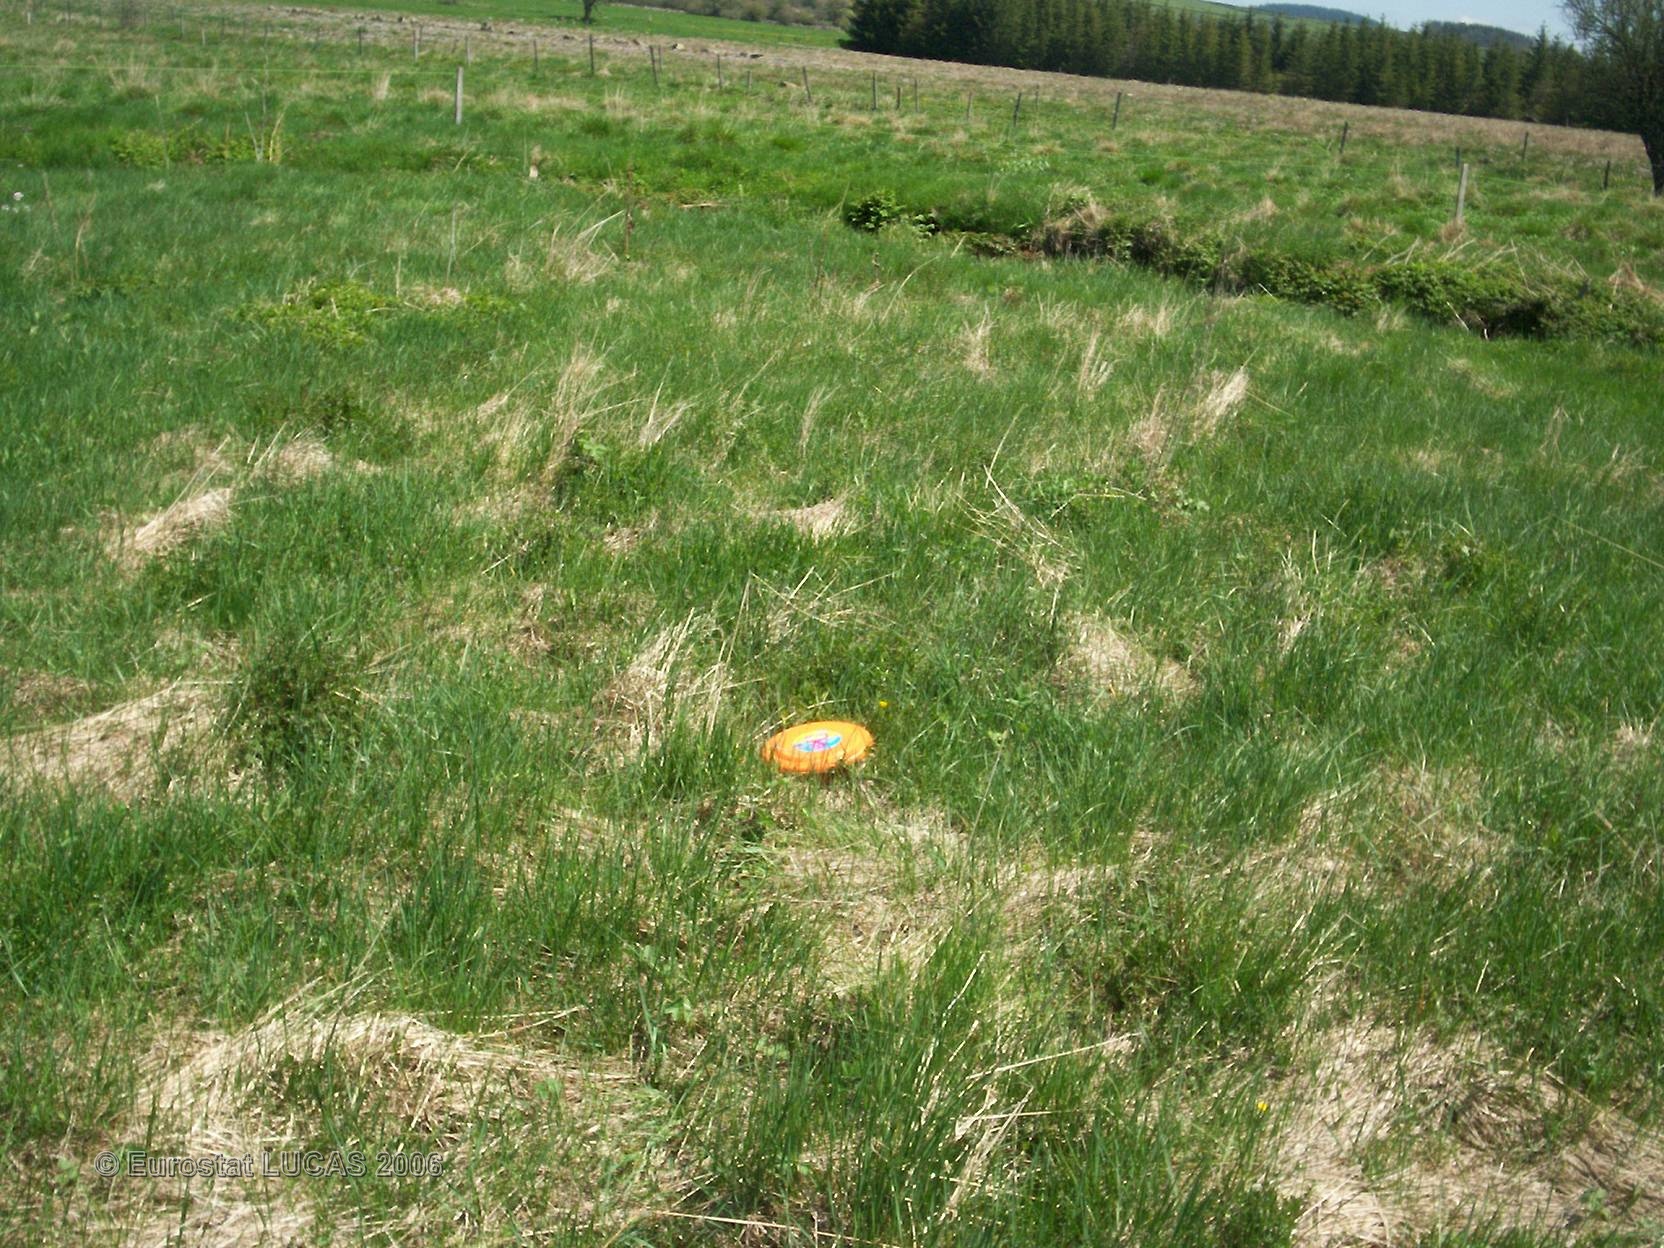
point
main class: Grassland
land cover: Grassland without tree/shrub cover
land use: Agriculture (excluding fallow land and kitchen gardens)
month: May
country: FR
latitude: 45.0200
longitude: 4.2053
